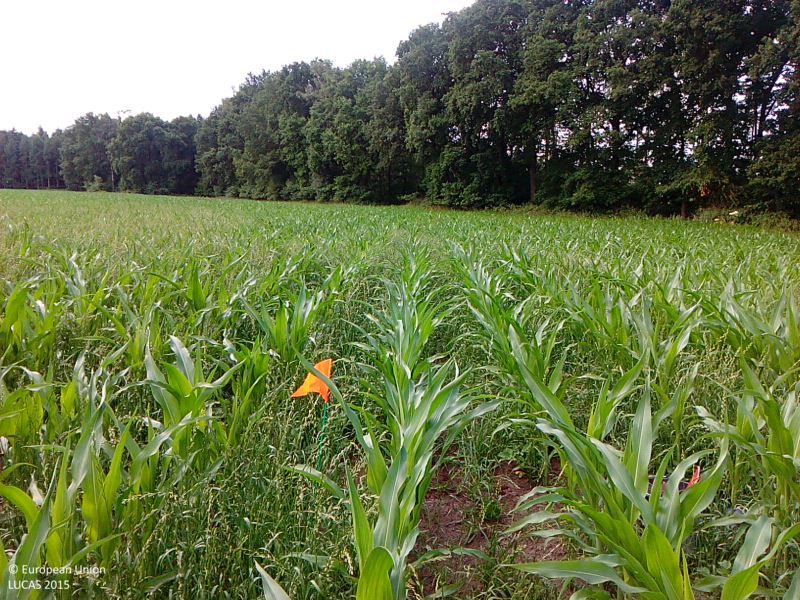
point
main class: Cropland
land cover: Maize
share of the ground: > 75 %
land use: Agriculture (excluding fallow land and kitchen gardens)
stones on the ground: < 10 %
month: July
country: DE
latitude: 52.7256
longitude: 7.3500
